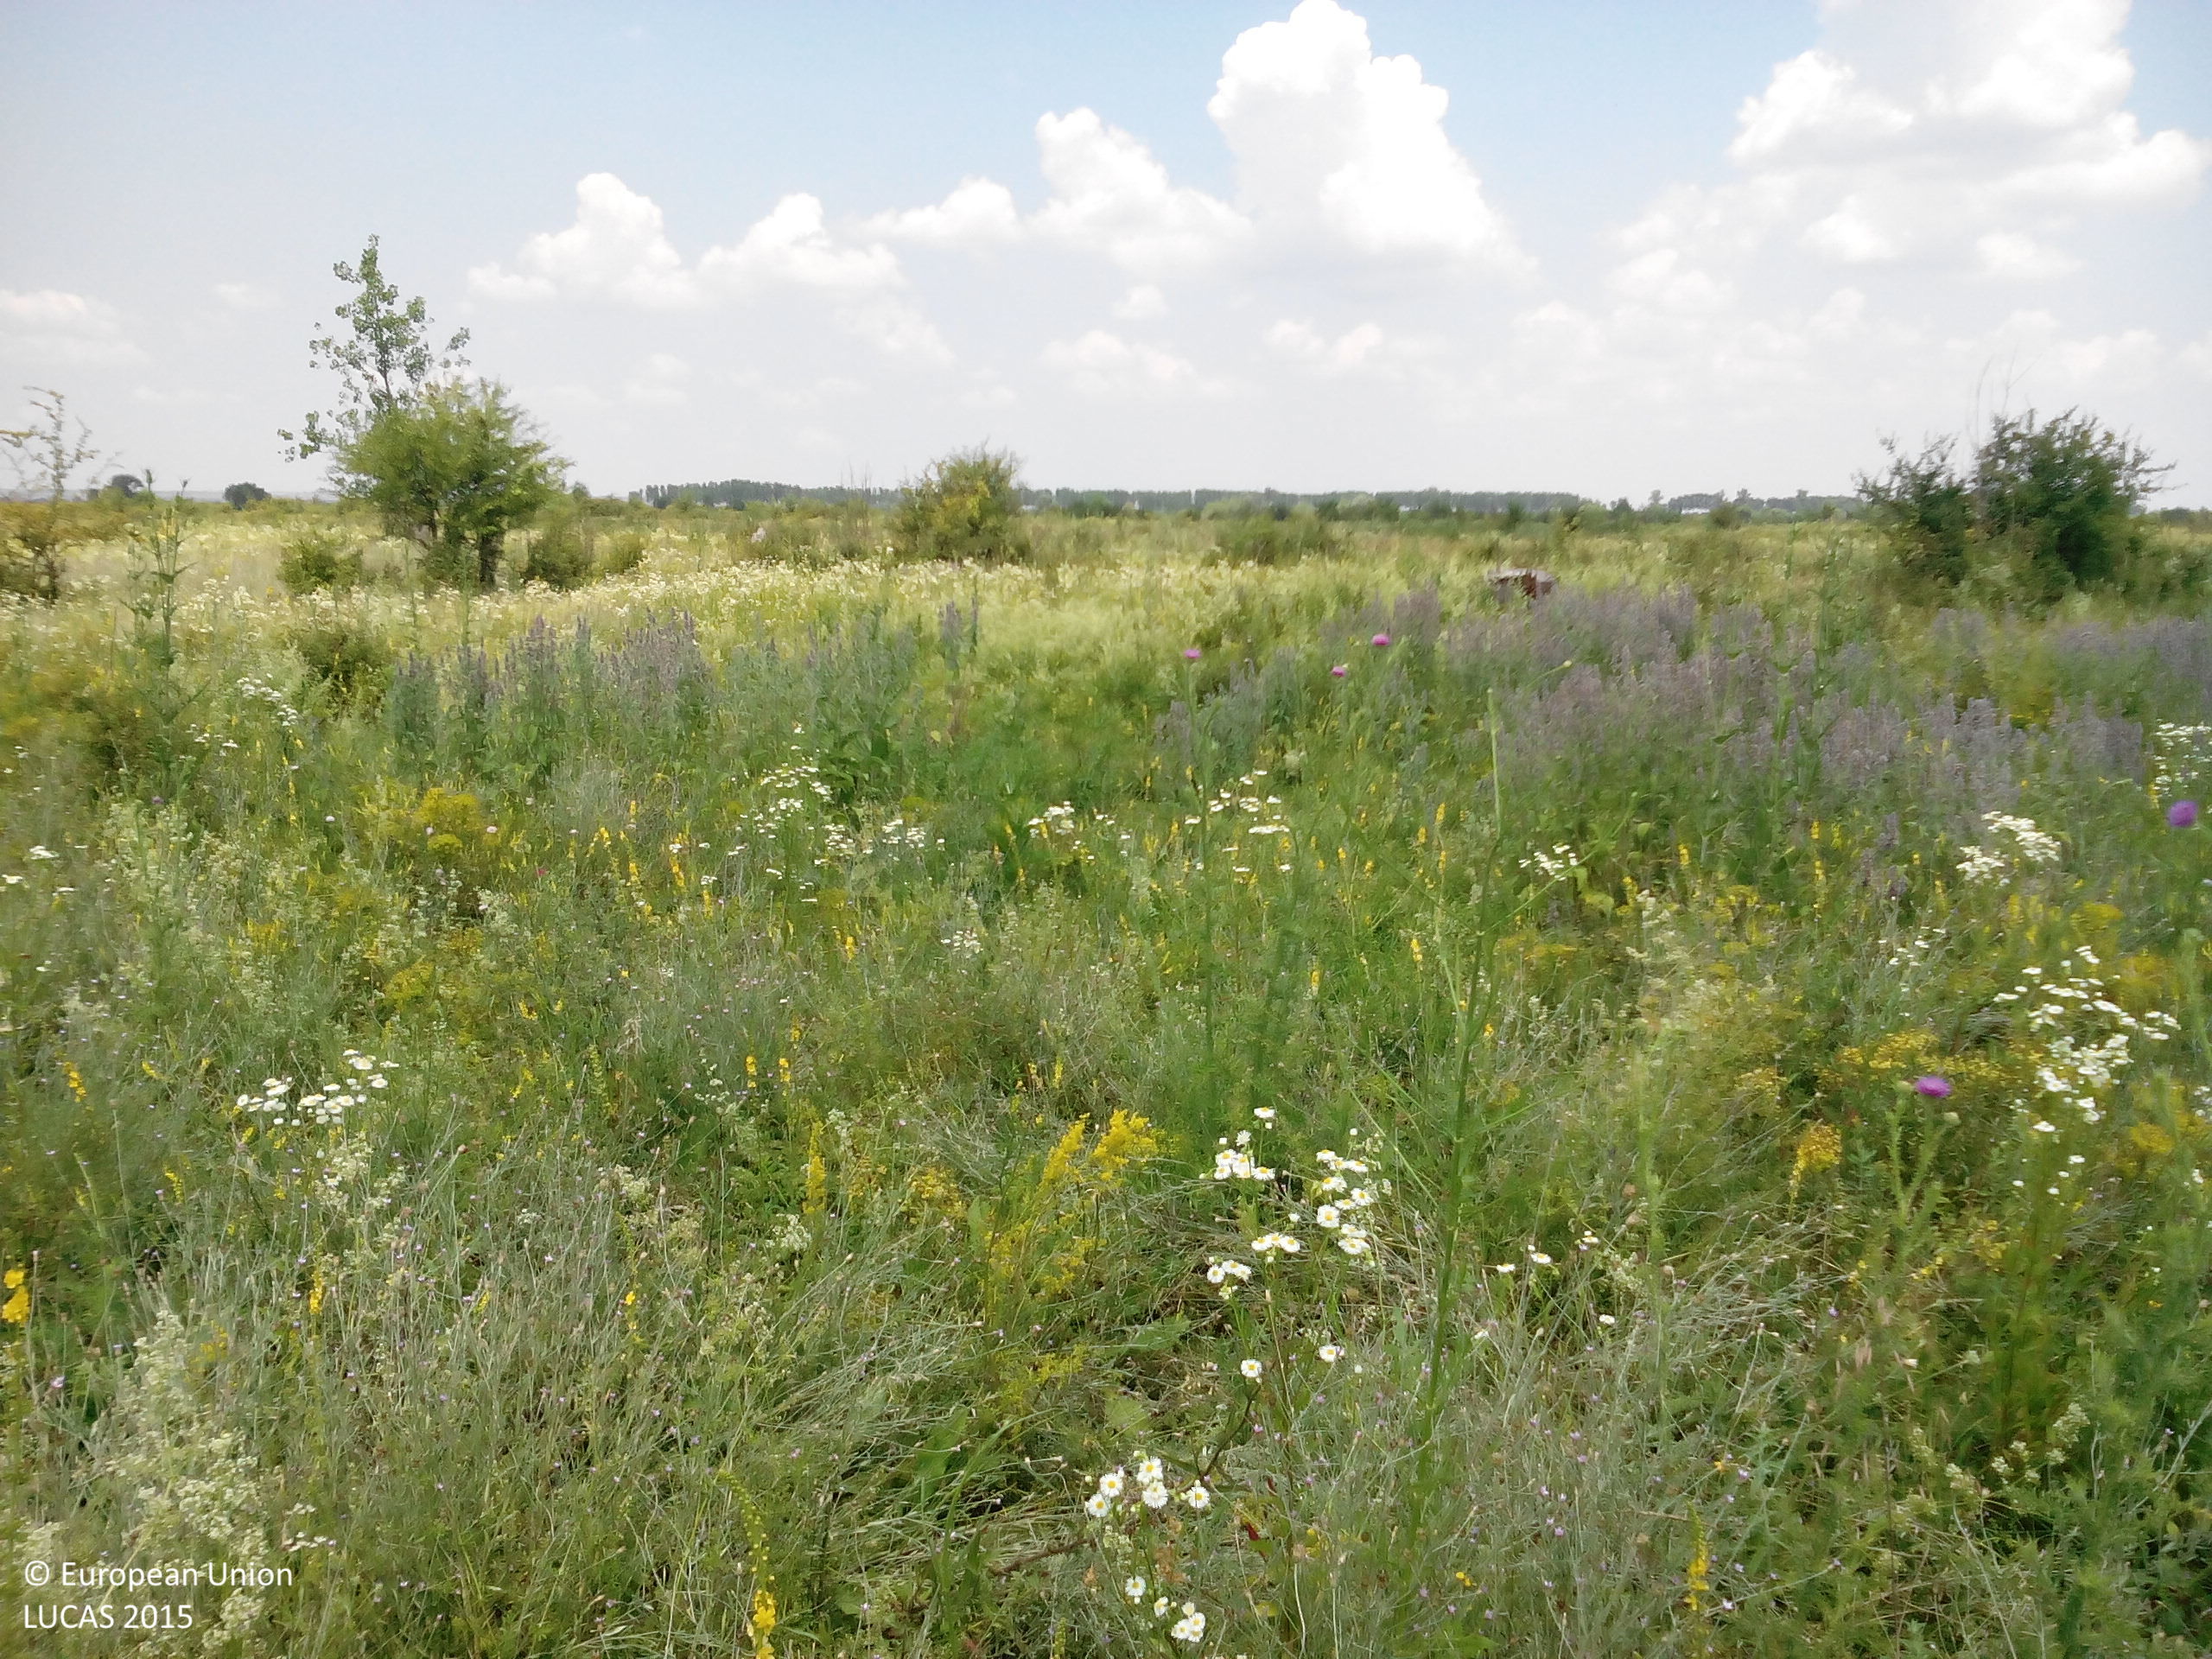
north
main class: Shrubland
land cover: Shrubland without tree cover
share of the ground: > 75 %
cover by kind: herbaceous plants 70 %, shrubs 30 %
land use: Semi-natural and natural areas not in use
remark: Clear cut
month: July
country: BG
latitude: 43.3526
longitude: 24.1809
